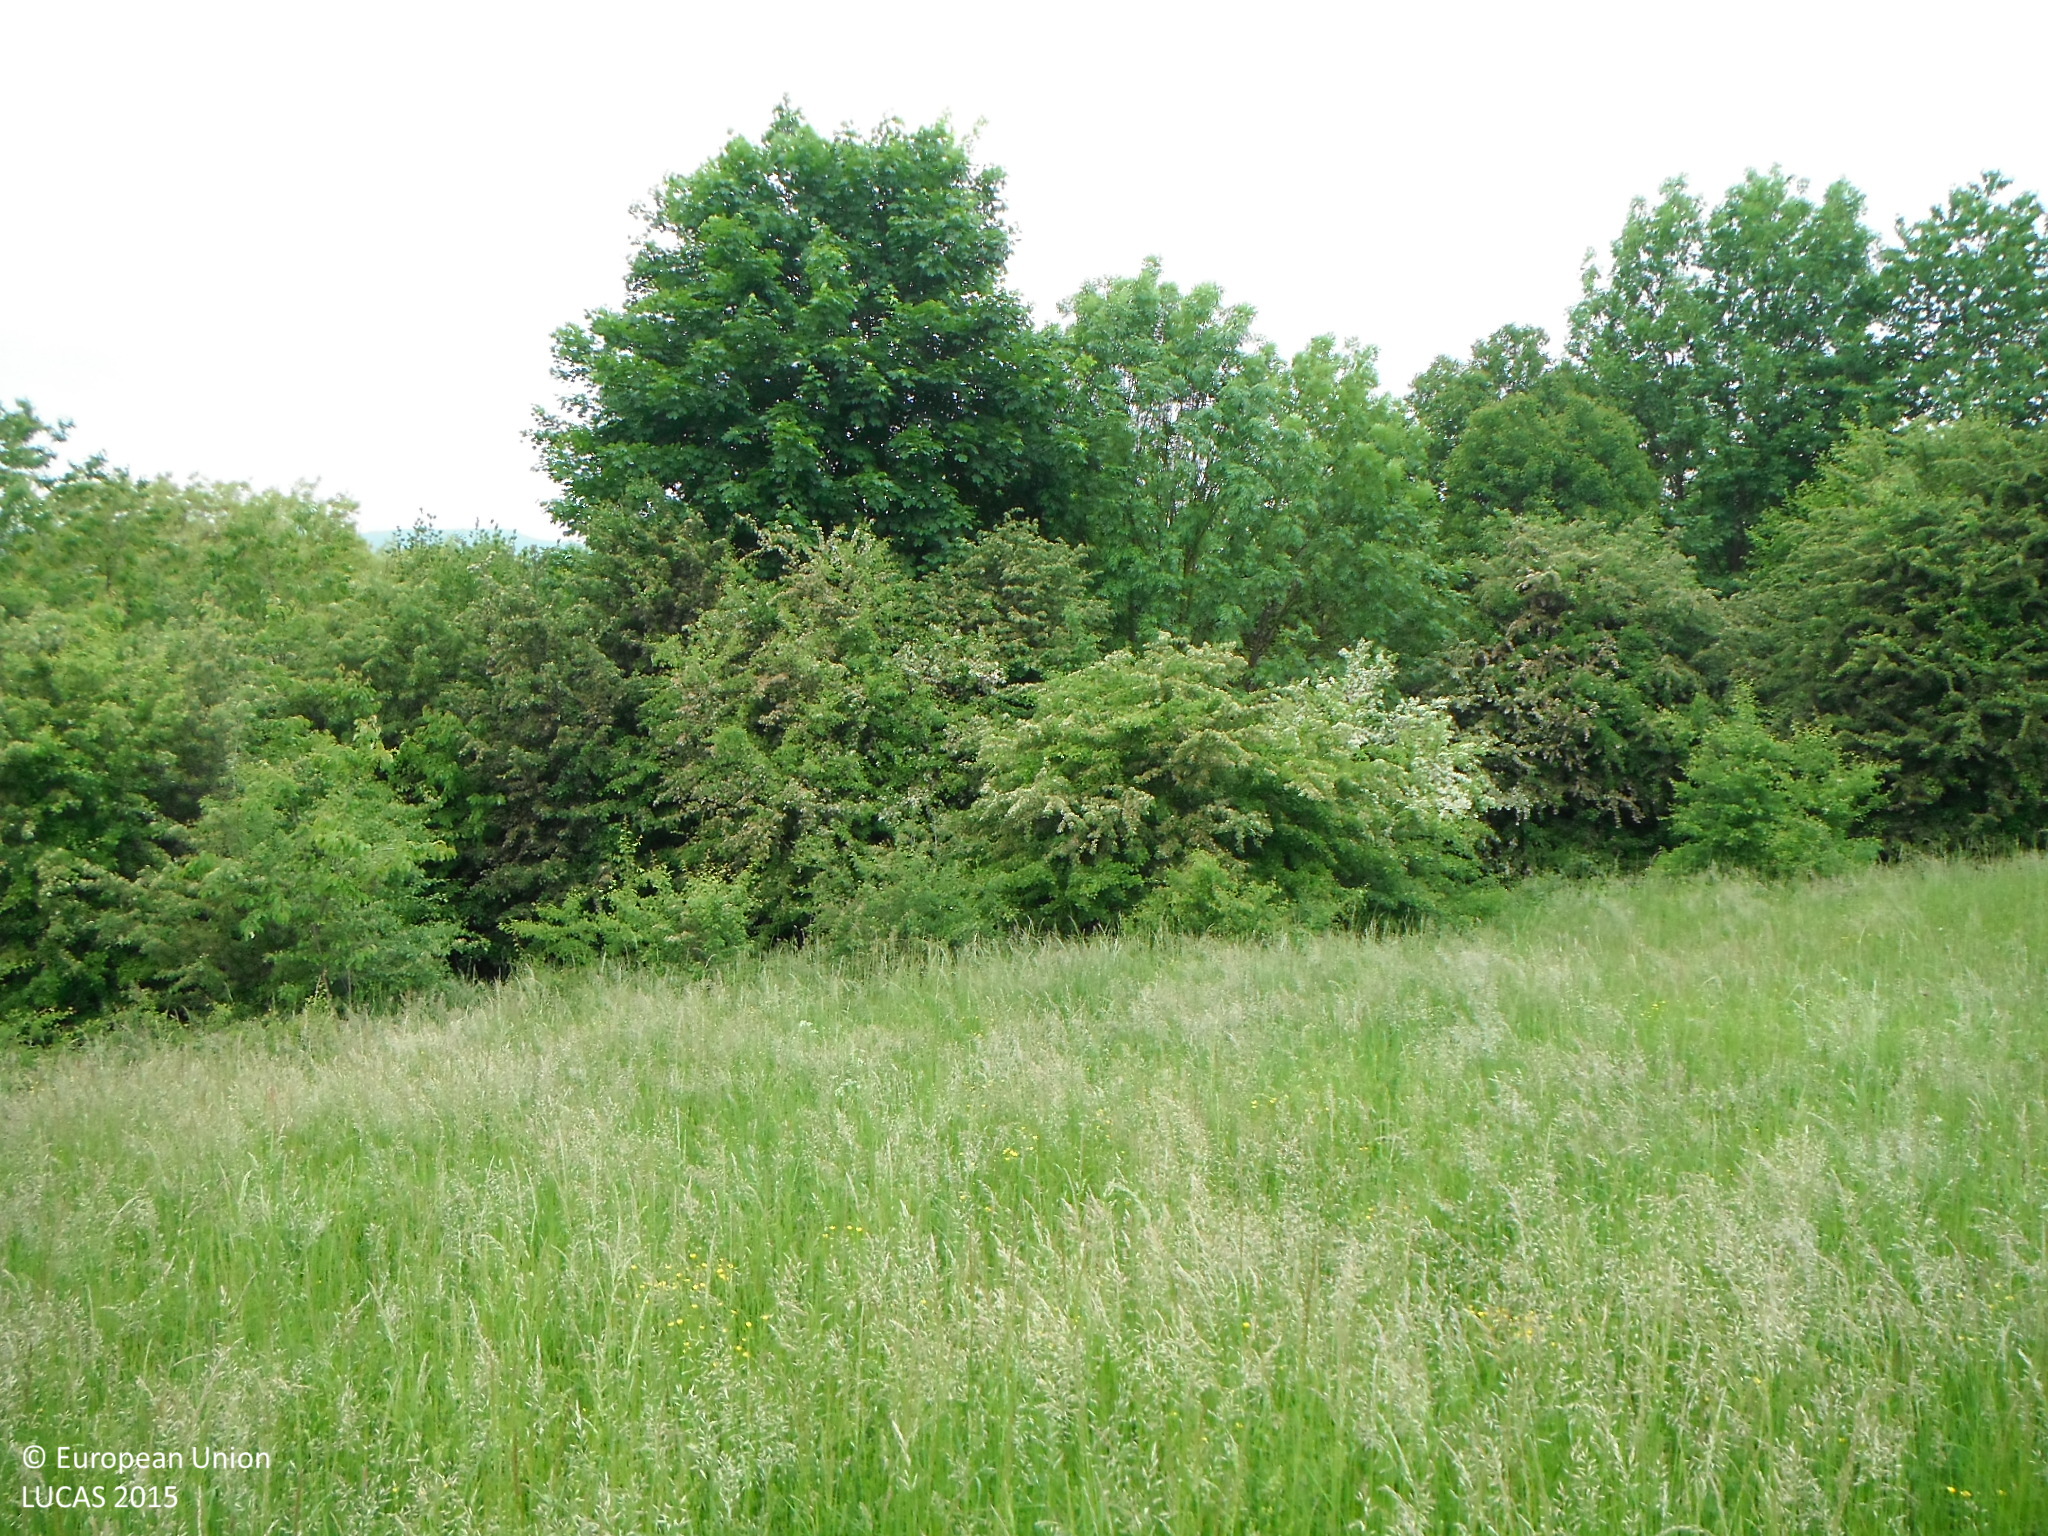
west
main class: Grassland
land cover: Grassland with sparse tree/shrub cover
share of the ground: > 75 %
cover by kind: herbaceous plants 85 %, shrubs 10 %, broadleaved forest trees 5 %
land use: Agriculture (excluding fallow land and kitchen gardens)
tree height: < 5 m
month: May
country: SK
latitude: 48.7456
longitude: 19.1751
